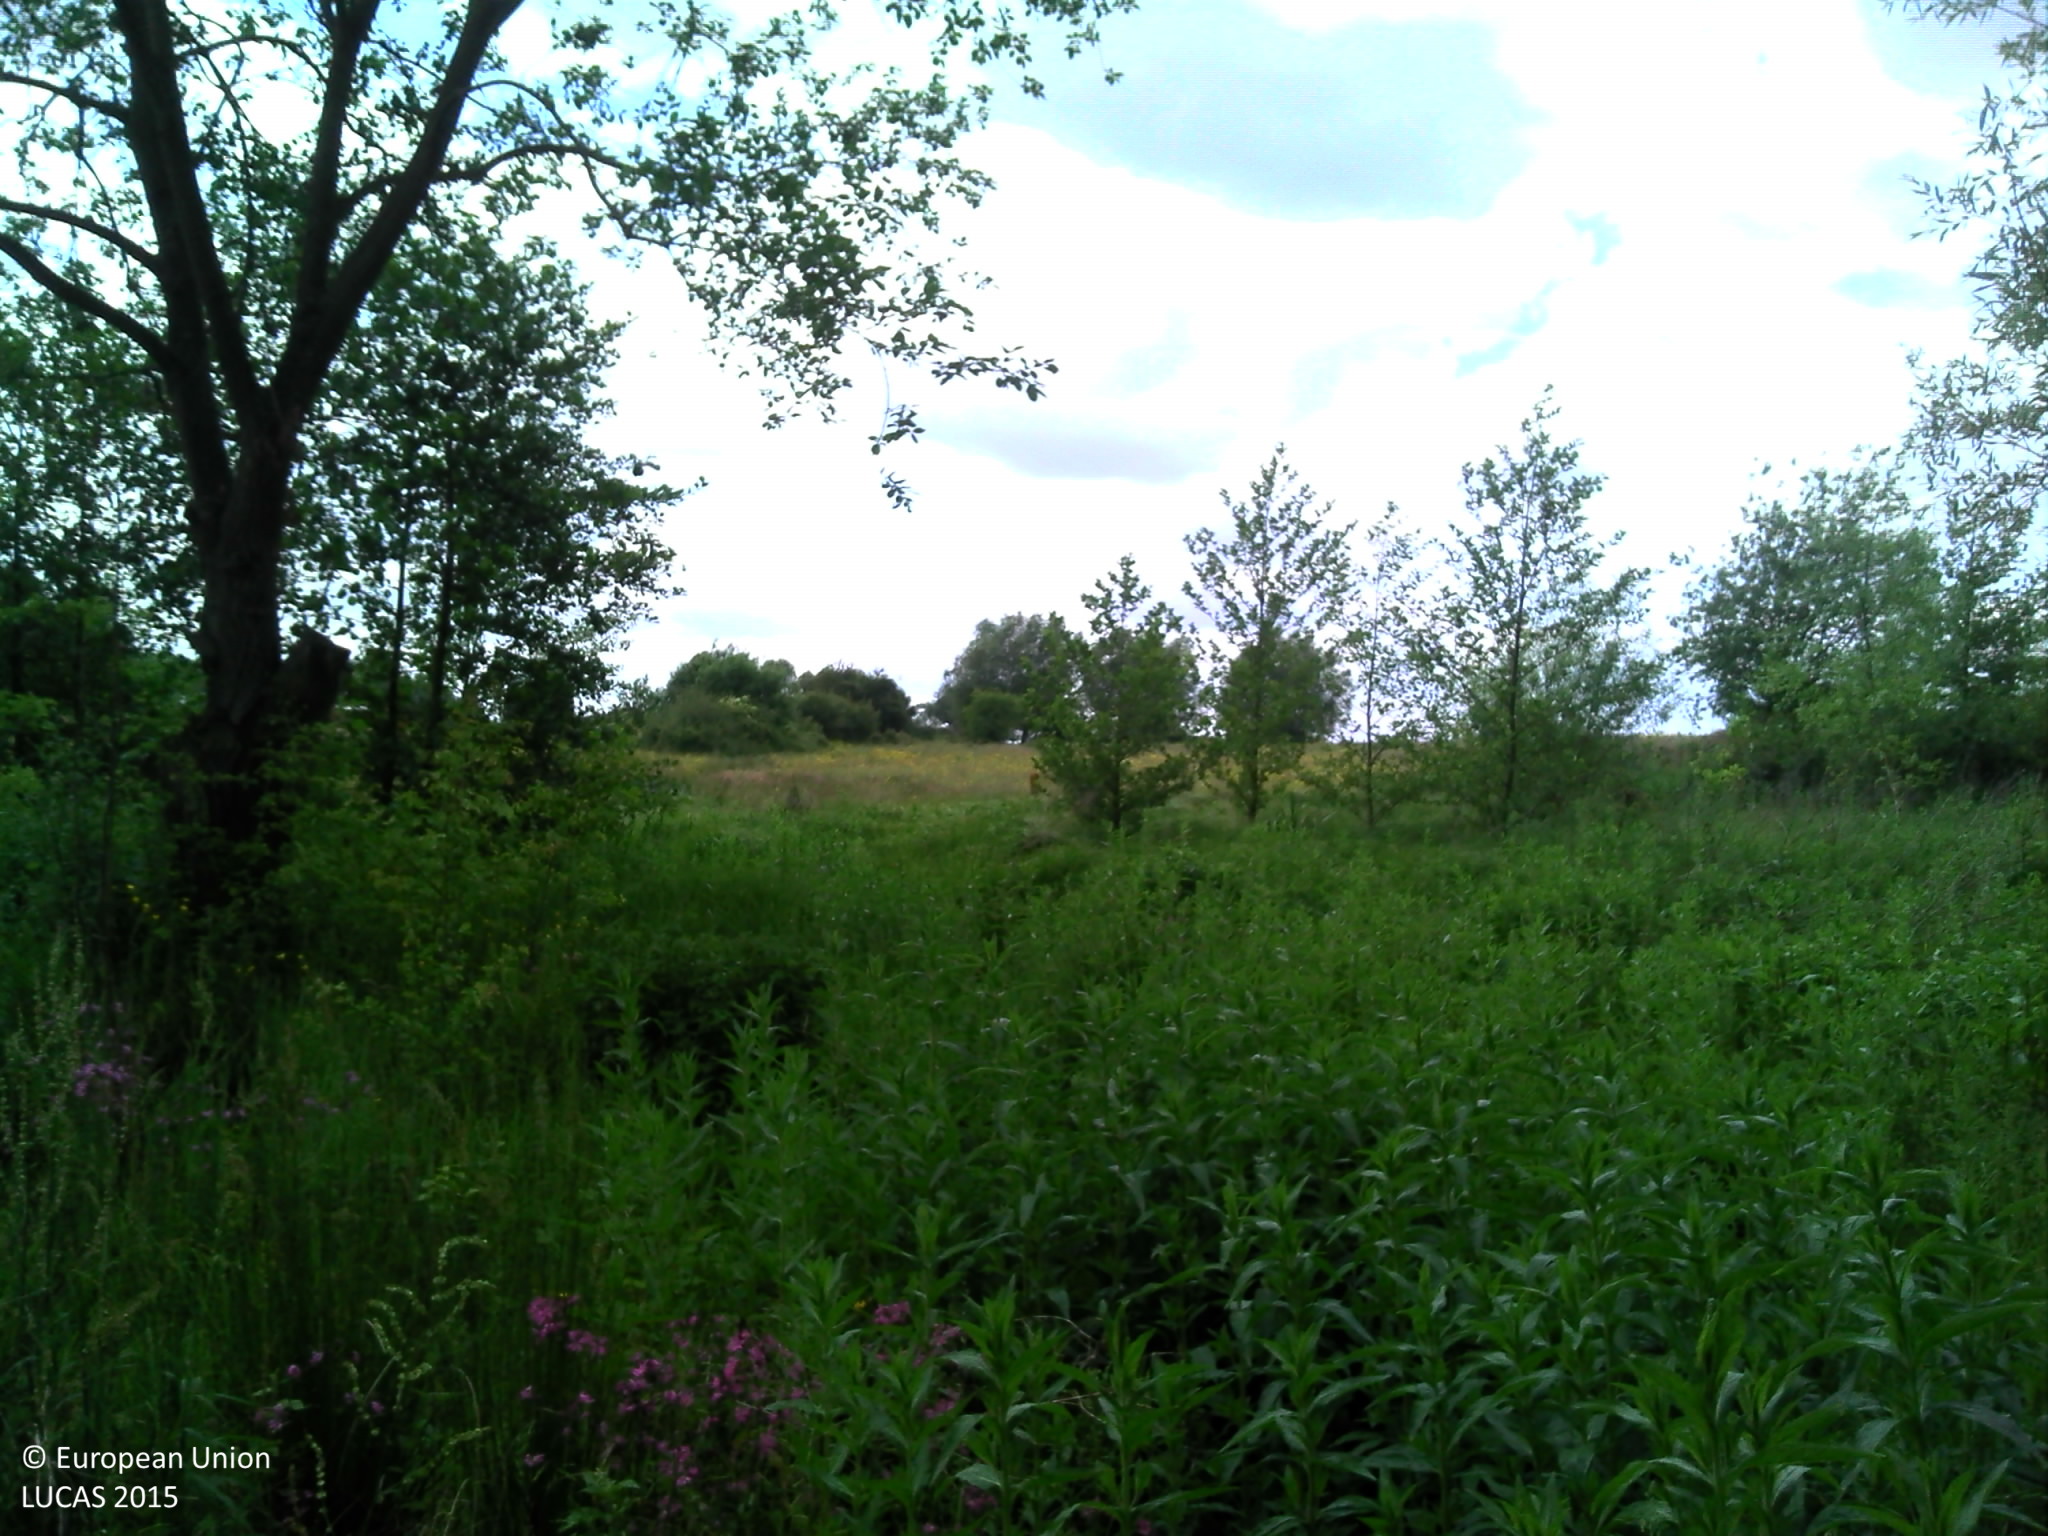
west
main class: Woodland
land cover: Broadleaved woodland
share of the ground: 50 - 75 %
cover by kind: broadleaved forest trees 60 %, herbaceous plants 40 %
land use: Forestry
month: June
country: BE
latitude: 50.7758
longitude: 3.8531
